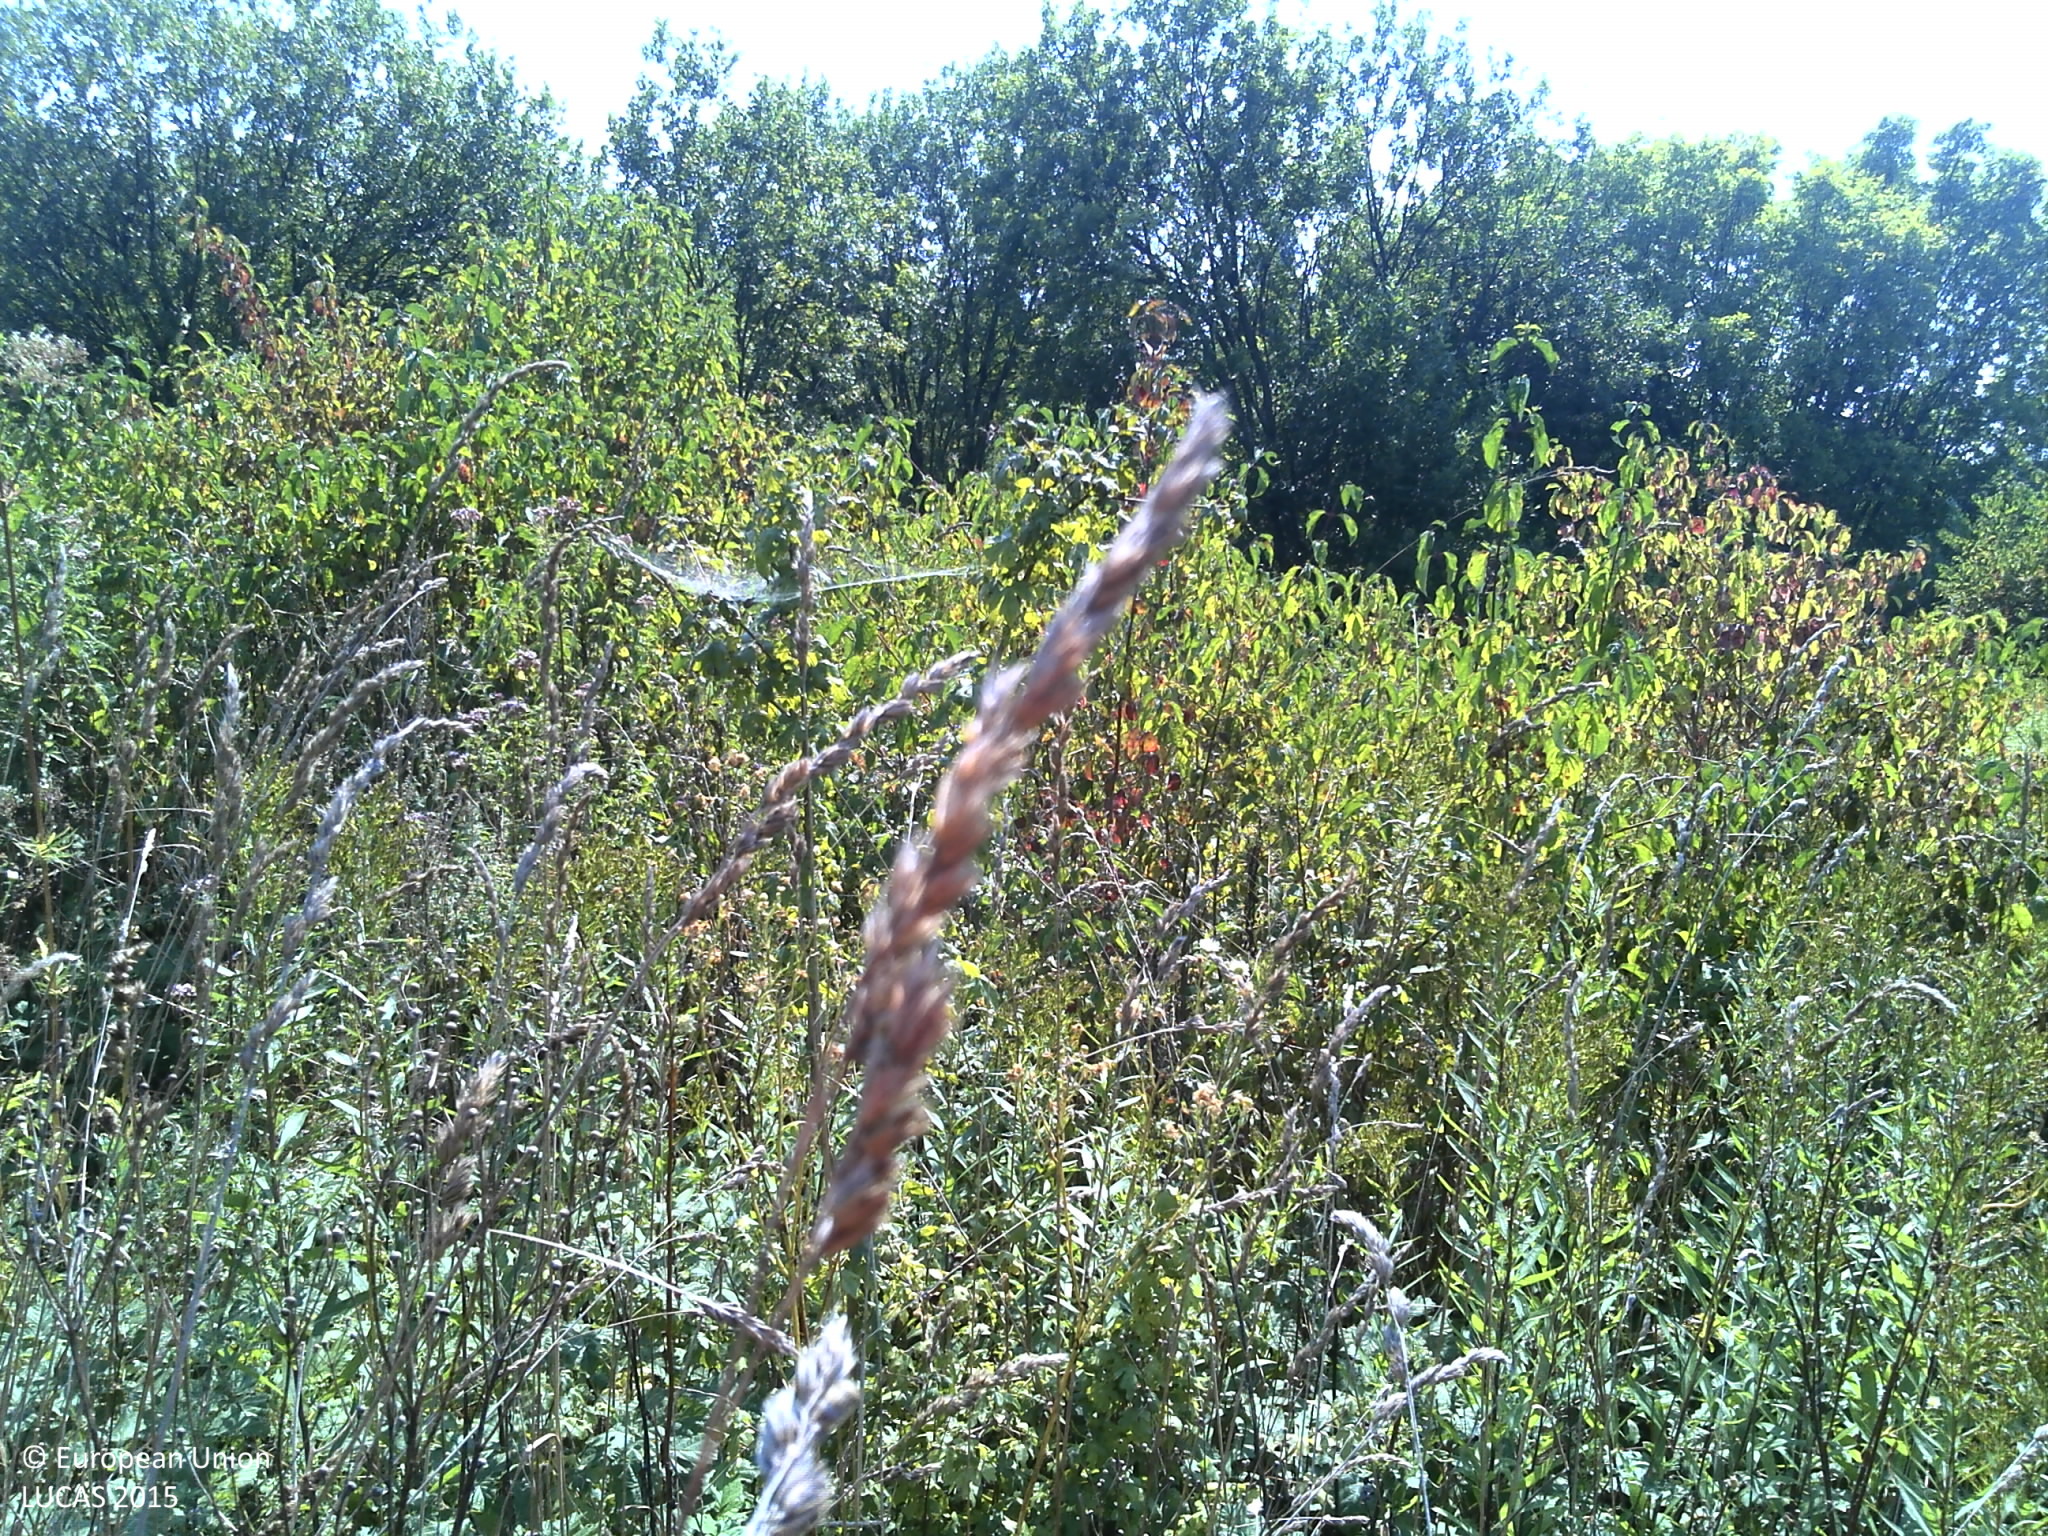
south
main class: Shrubland
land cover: Shrubland with sparse tree cover
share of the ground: > 75 %
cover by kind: shrubs 95 %, broadleaved forest trees 5 %
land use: Semi-natural and natural areas not in use
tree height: < 5 m
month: August
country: HR
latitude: 45.1447
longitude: 16.4449
